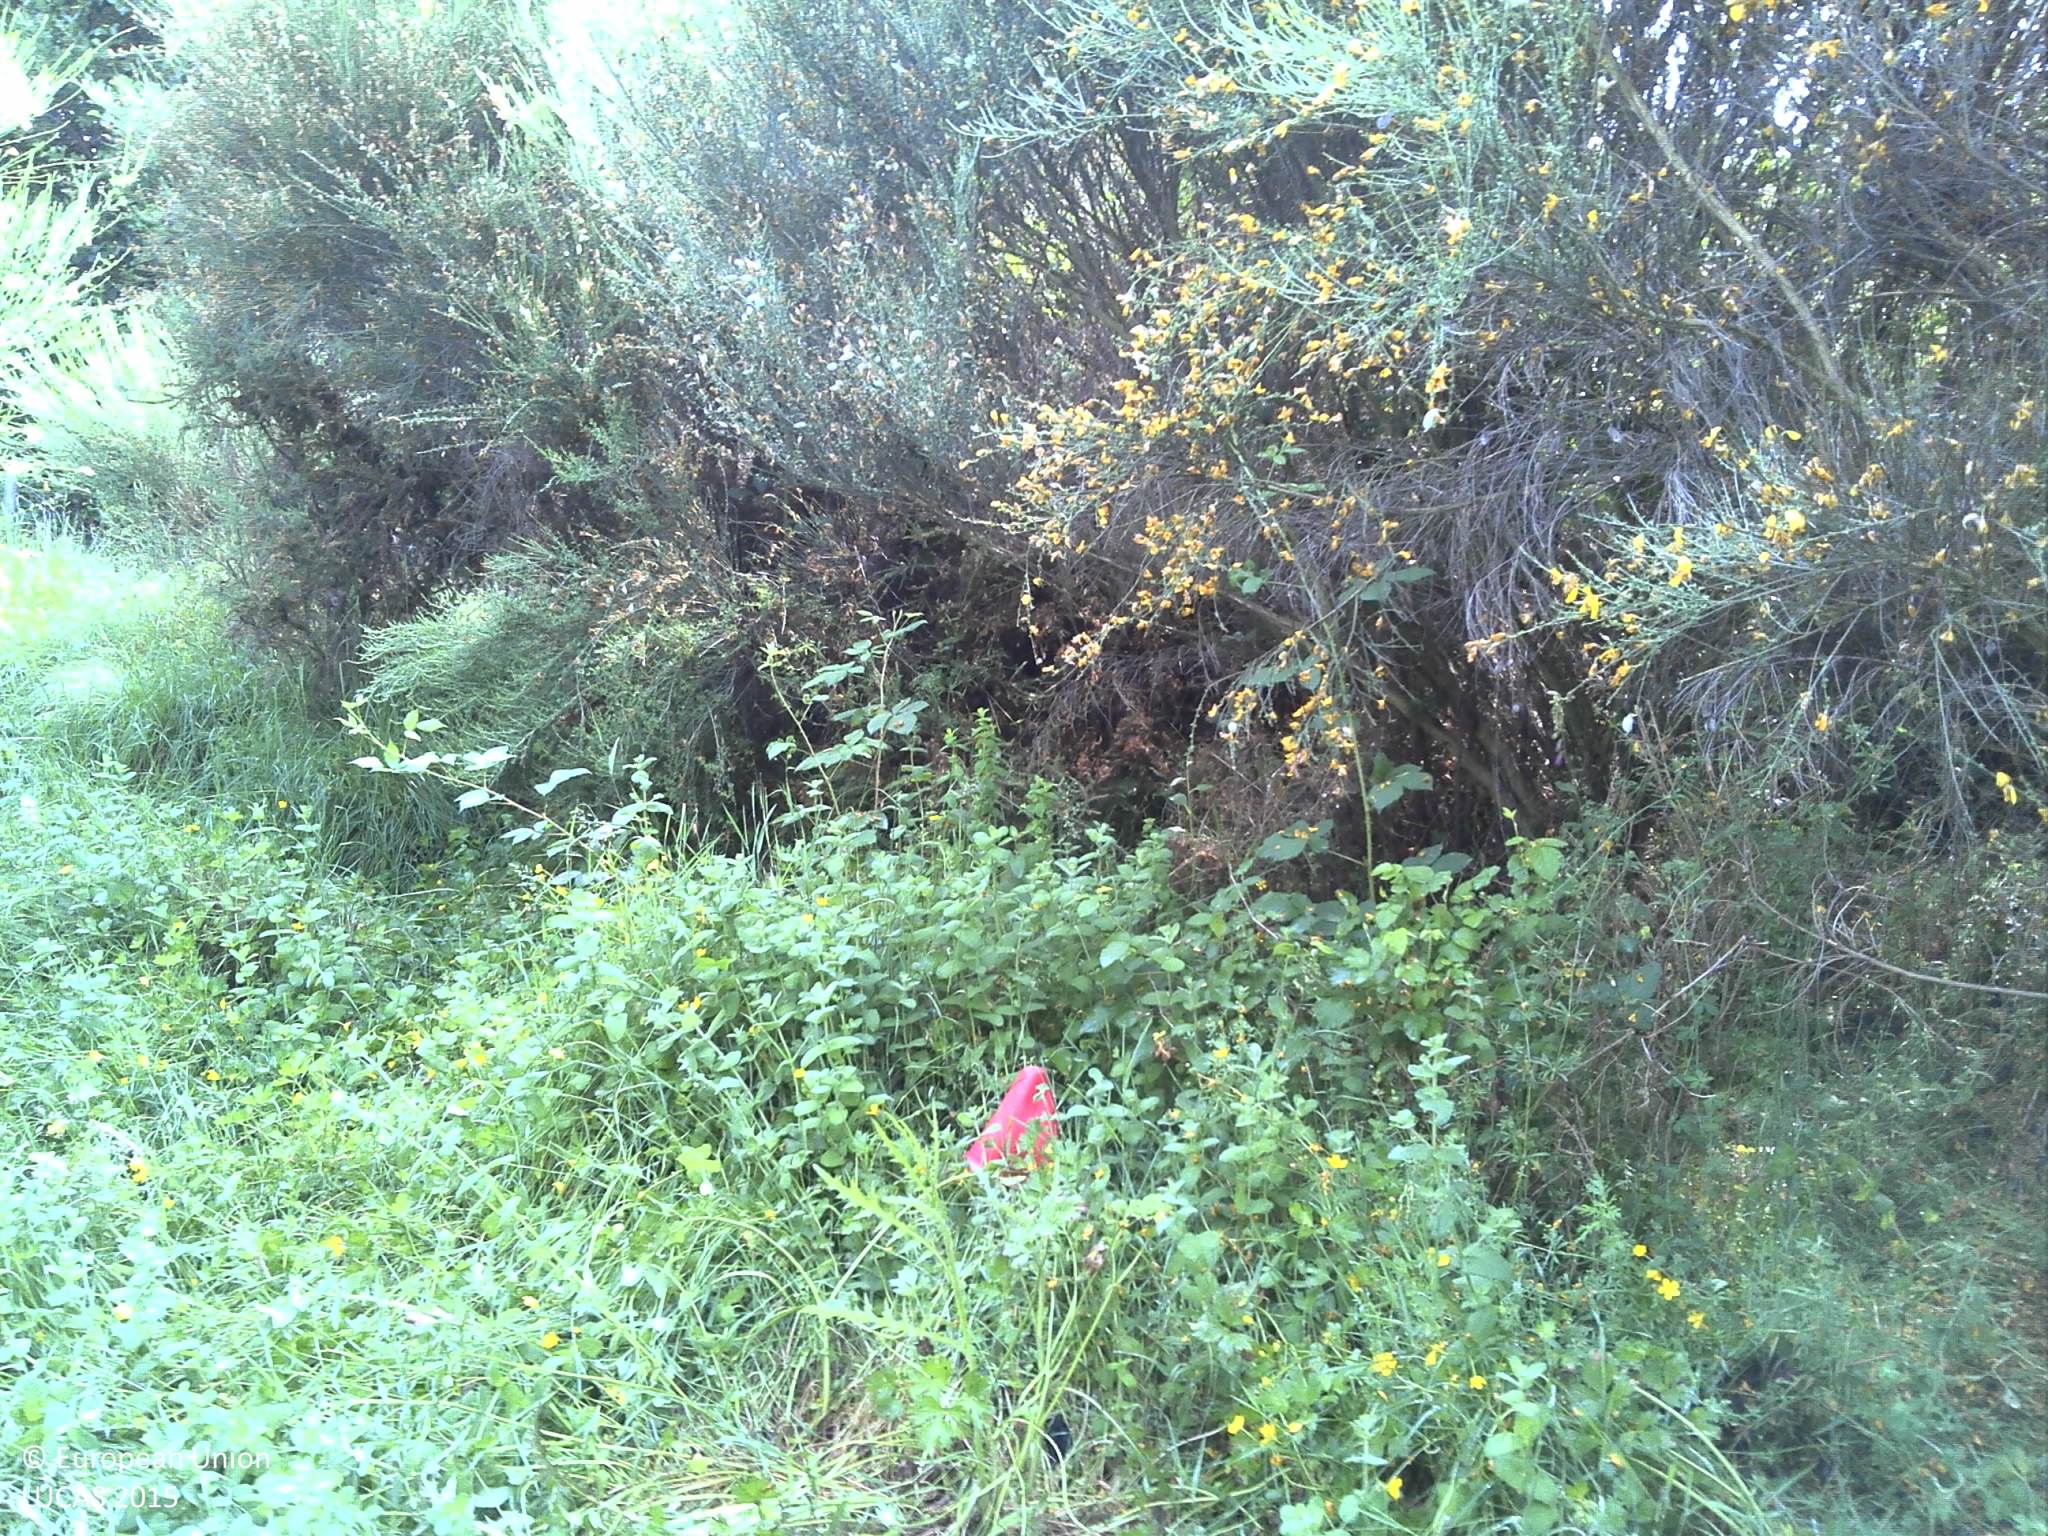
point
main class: Shrubland
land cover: Shrubland with sparse tree cover
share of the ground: > 75 %
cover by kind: shrubs 85 %, herbaceous plants 10 %, broadleaved forest trees 5 %
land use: Semi-natural and natural areas not in use
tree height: > 5 m
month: June
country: PT
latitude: 41.4275
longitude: -7.5132
